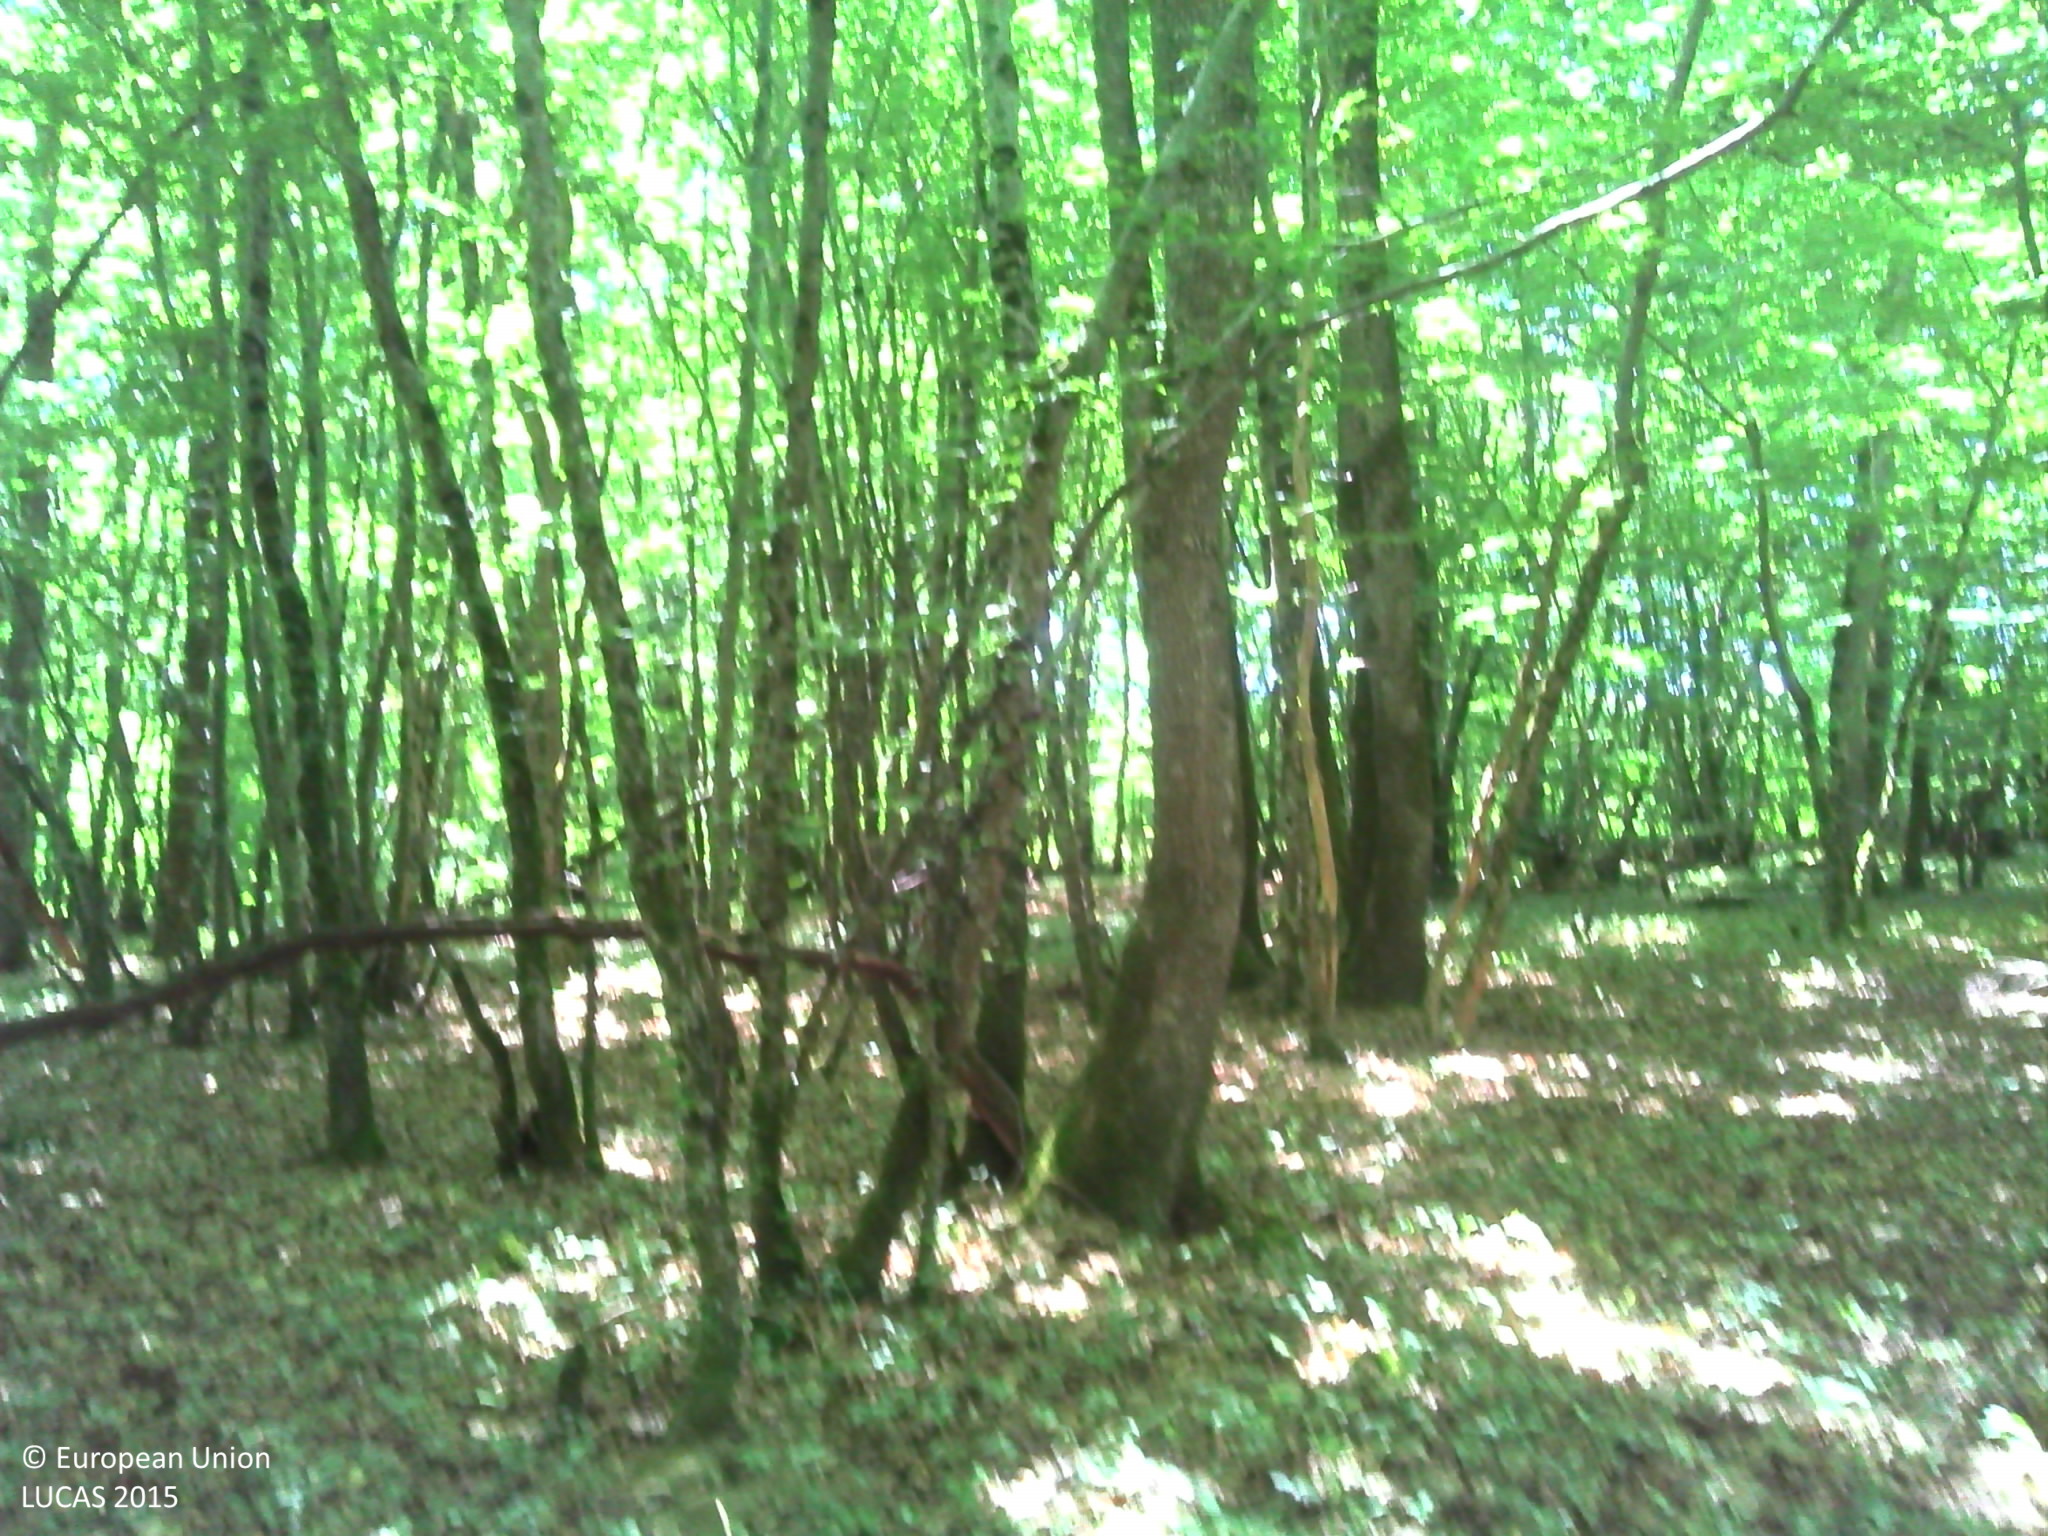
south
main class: Woodland
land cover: Broadleaved woodland
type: mesophytic deciduous forest
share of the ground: > 75 %
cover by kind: broadleaved forest trees 90 %, unconsolidated bare surface 10 %
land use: Forestry
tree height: > 5 m
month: June
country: FR
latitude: 47.1305
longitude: 2.6772
